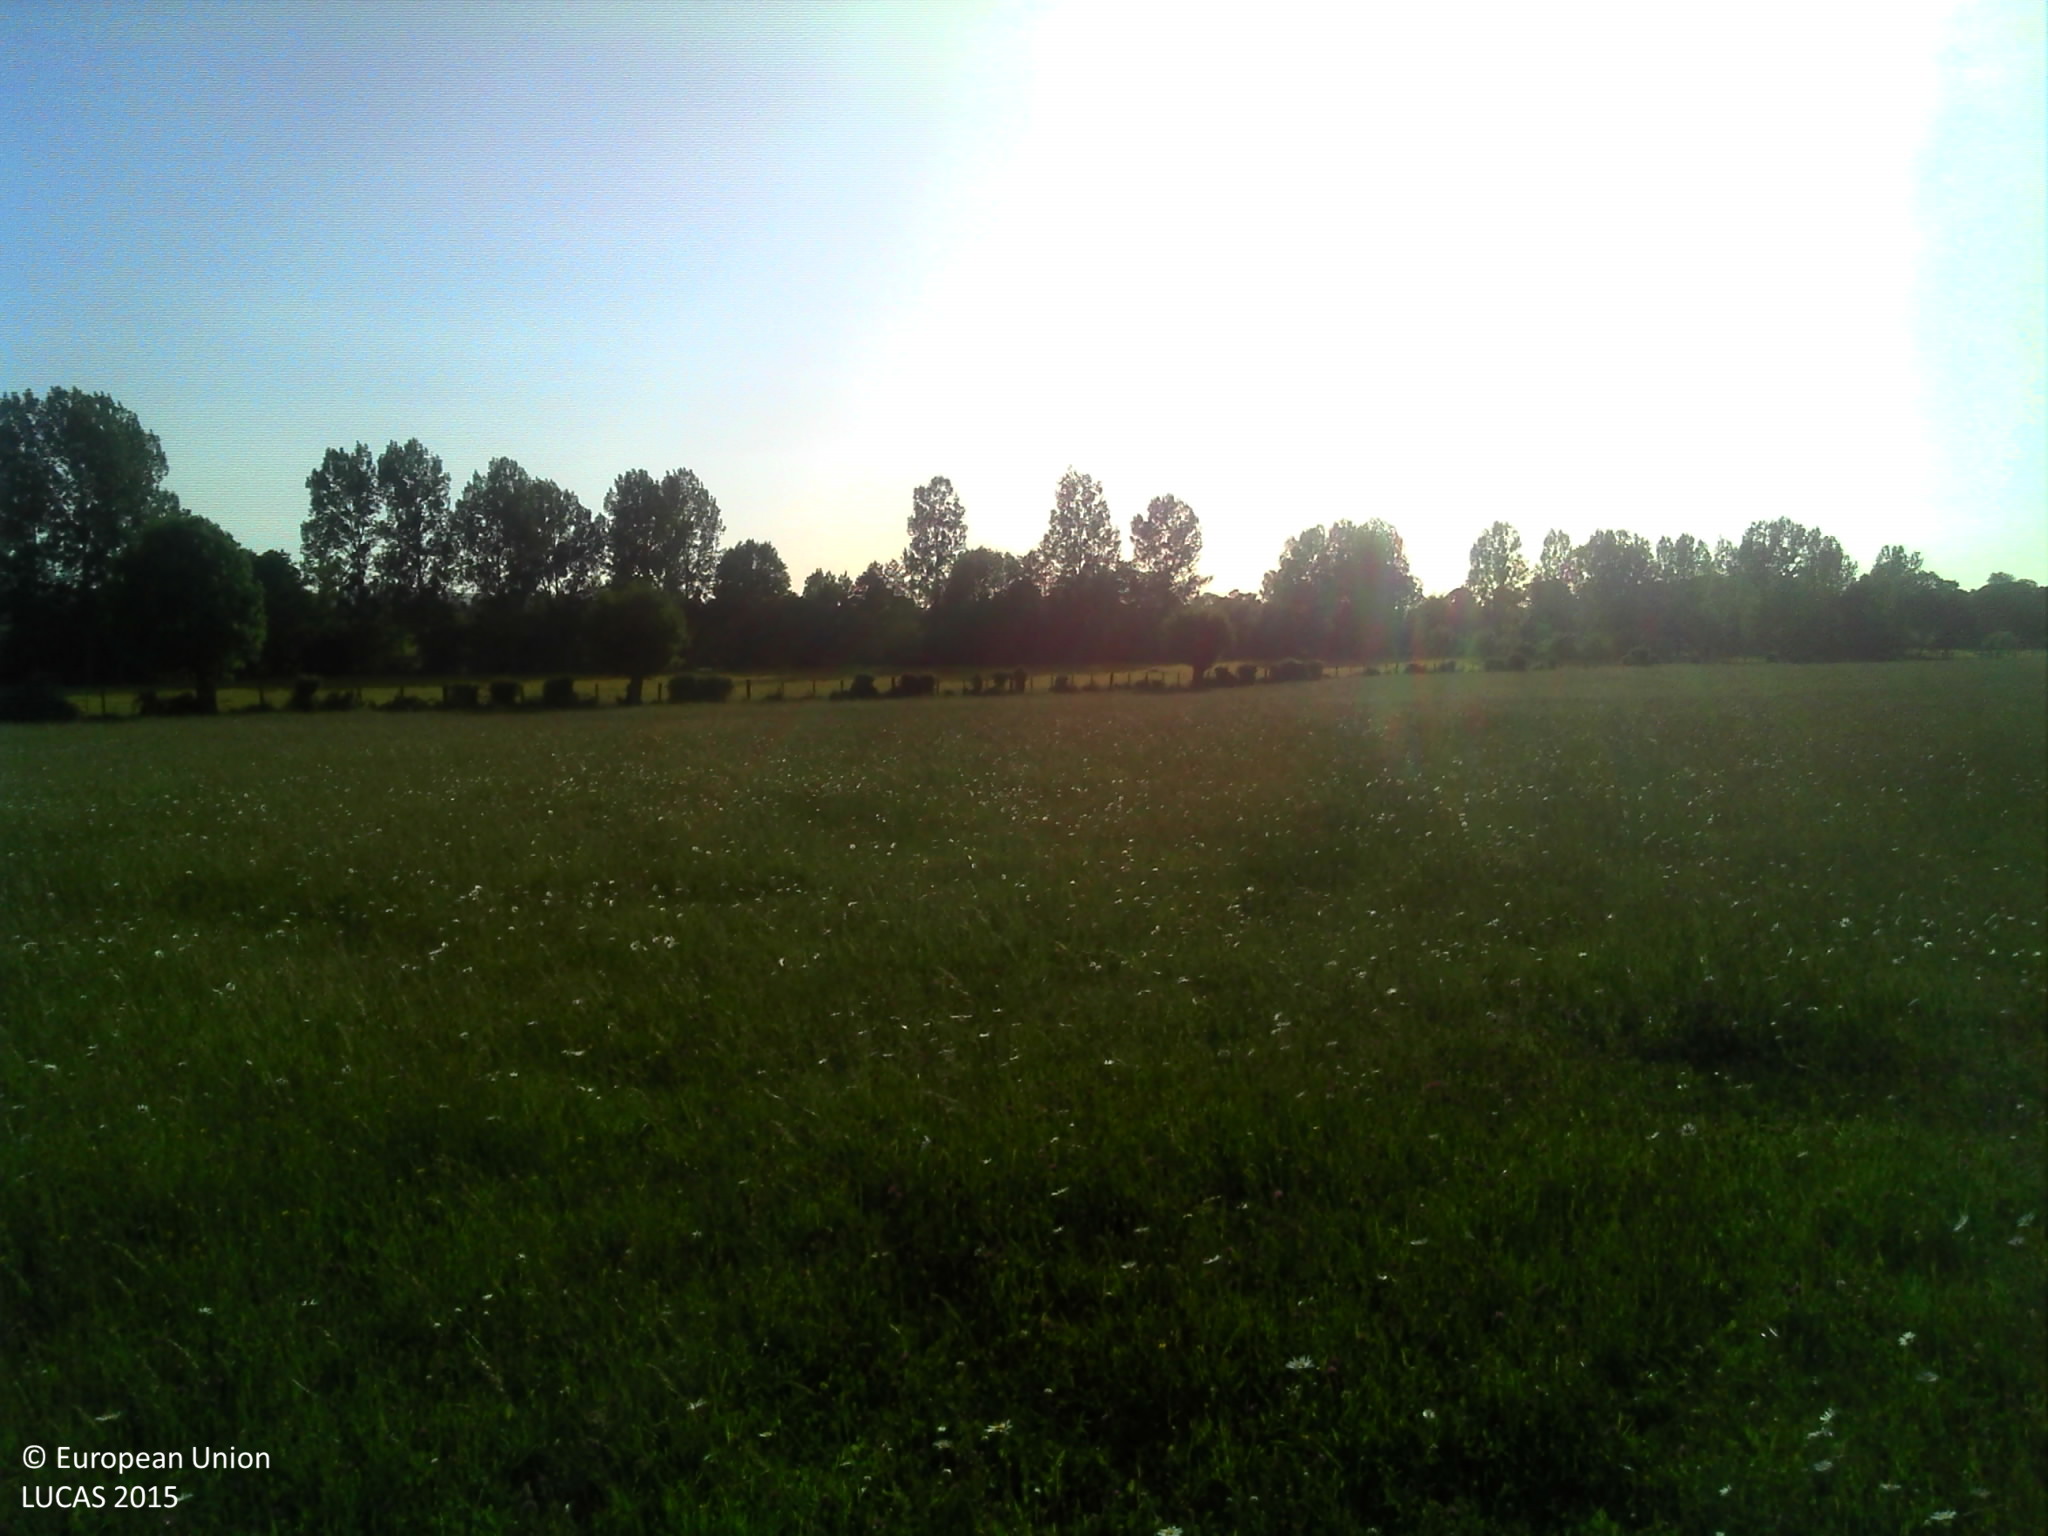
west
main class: Grassland
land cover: Grassland without tree/shrub cover
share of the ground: > 75 %
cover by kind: herbaceous plants 95 %
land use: Agriculture (excluding fallow land and kitchen gardens)
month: June
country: FR
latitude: 48.8099
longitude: 0.0983
